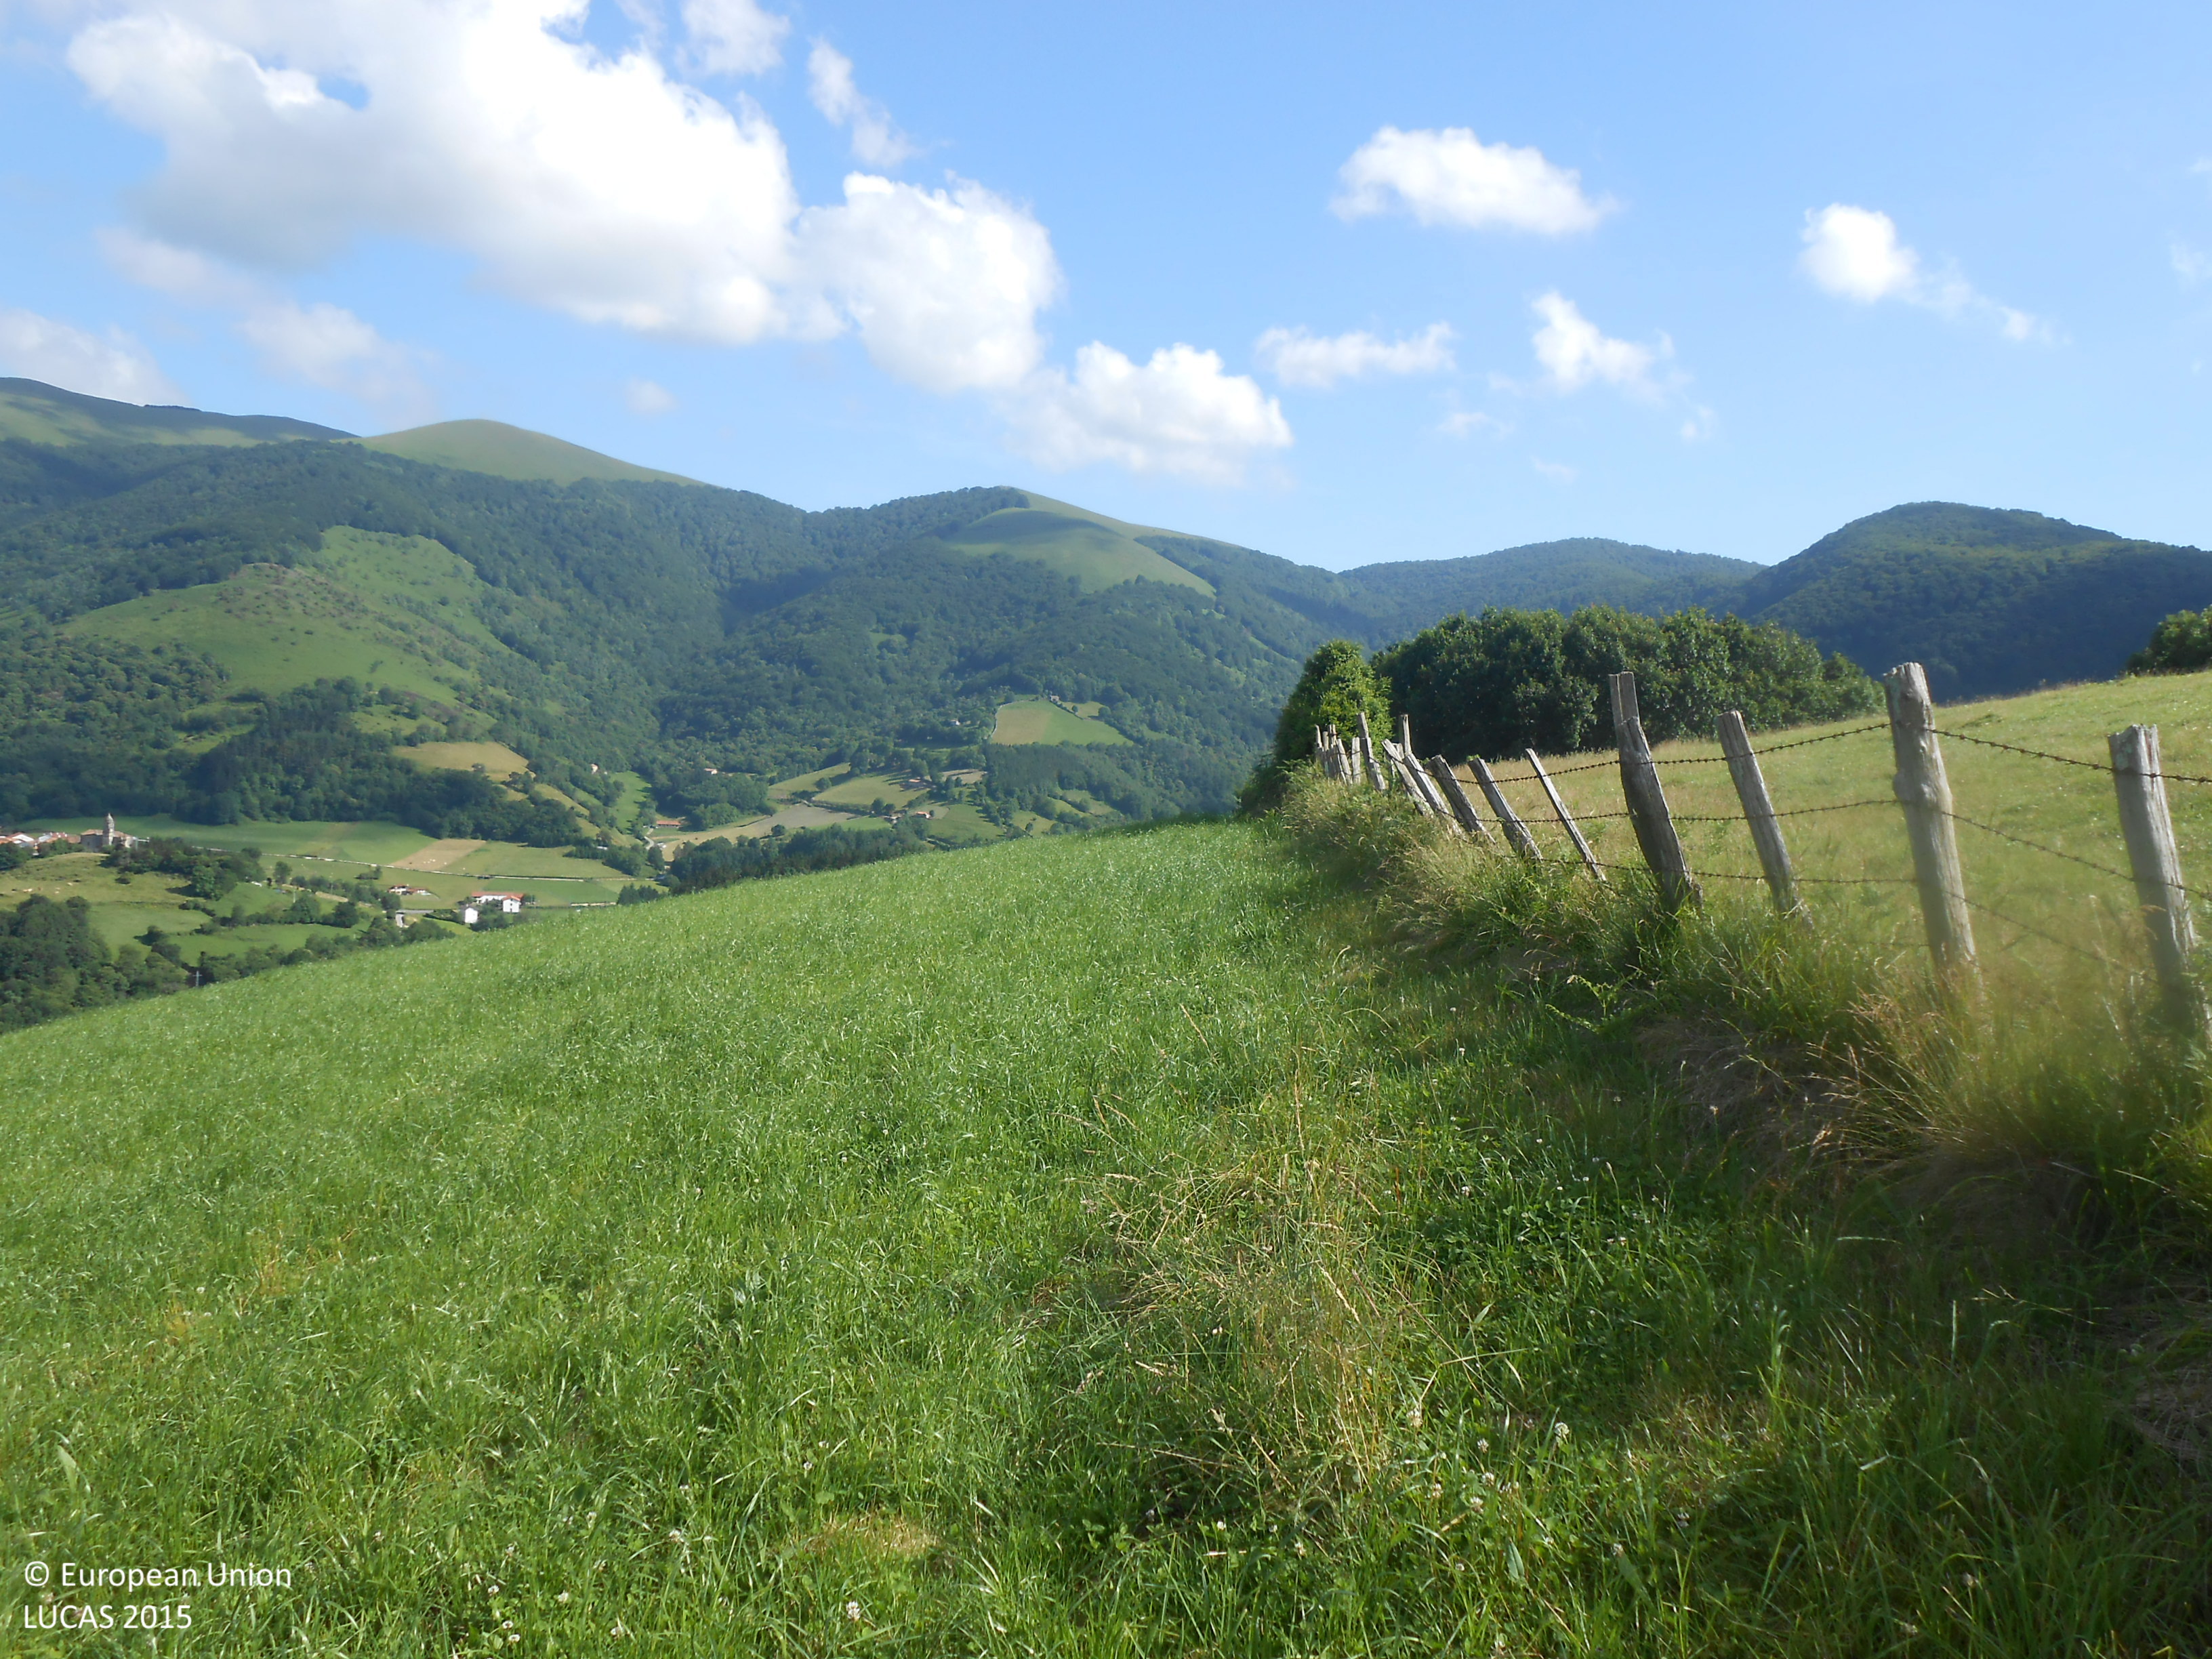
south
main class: Grassland
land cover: Grassland without tree/shrub cover
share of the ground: > 75 %
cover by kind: herbaceous plants 100 %
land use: Agriculture (excluding fallow land and kitchen gardens)
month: June
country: ES
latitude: 43.0975
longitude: -1.7514
